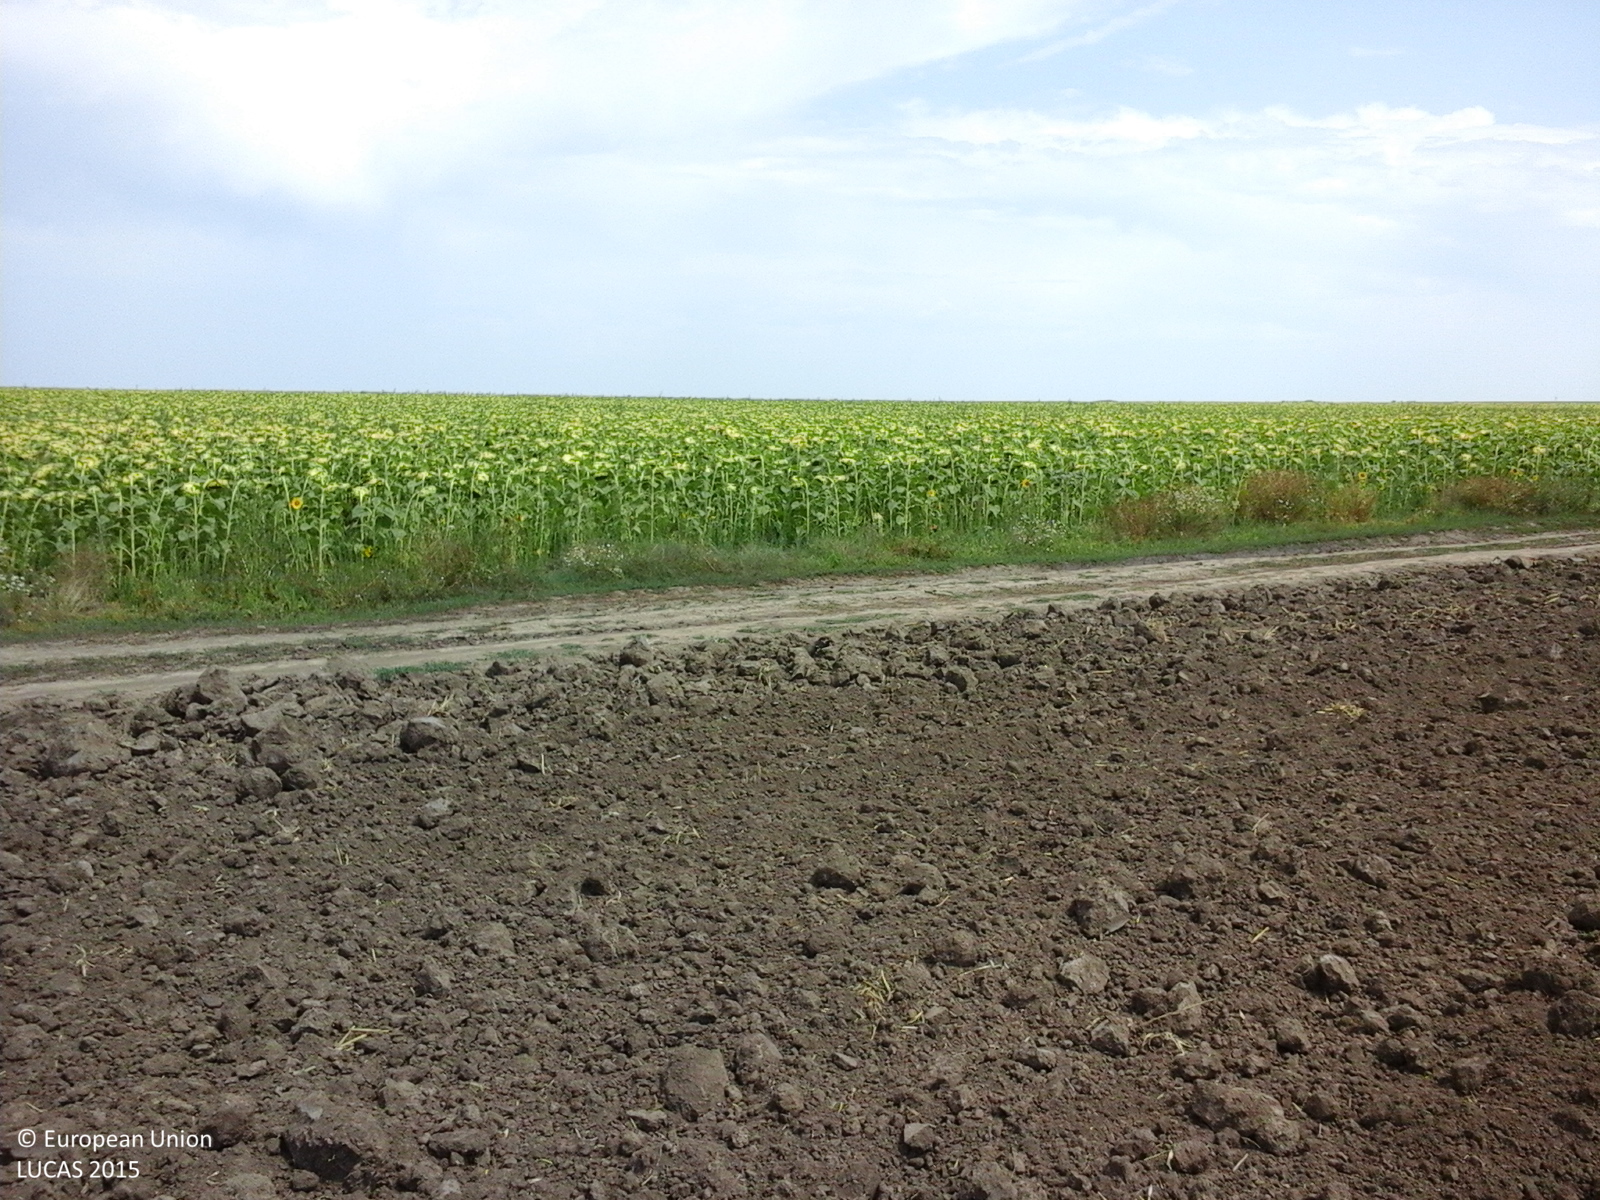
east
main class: Cropland
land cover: Common wheat
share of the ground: < 10 %
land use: Agriculture (excluding fallow land and kitchen gardens)
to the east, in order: Common wheat; Tracks; Grass margins; Sunflower
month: August
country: RO
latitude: 43.9229
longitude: 28.4099
